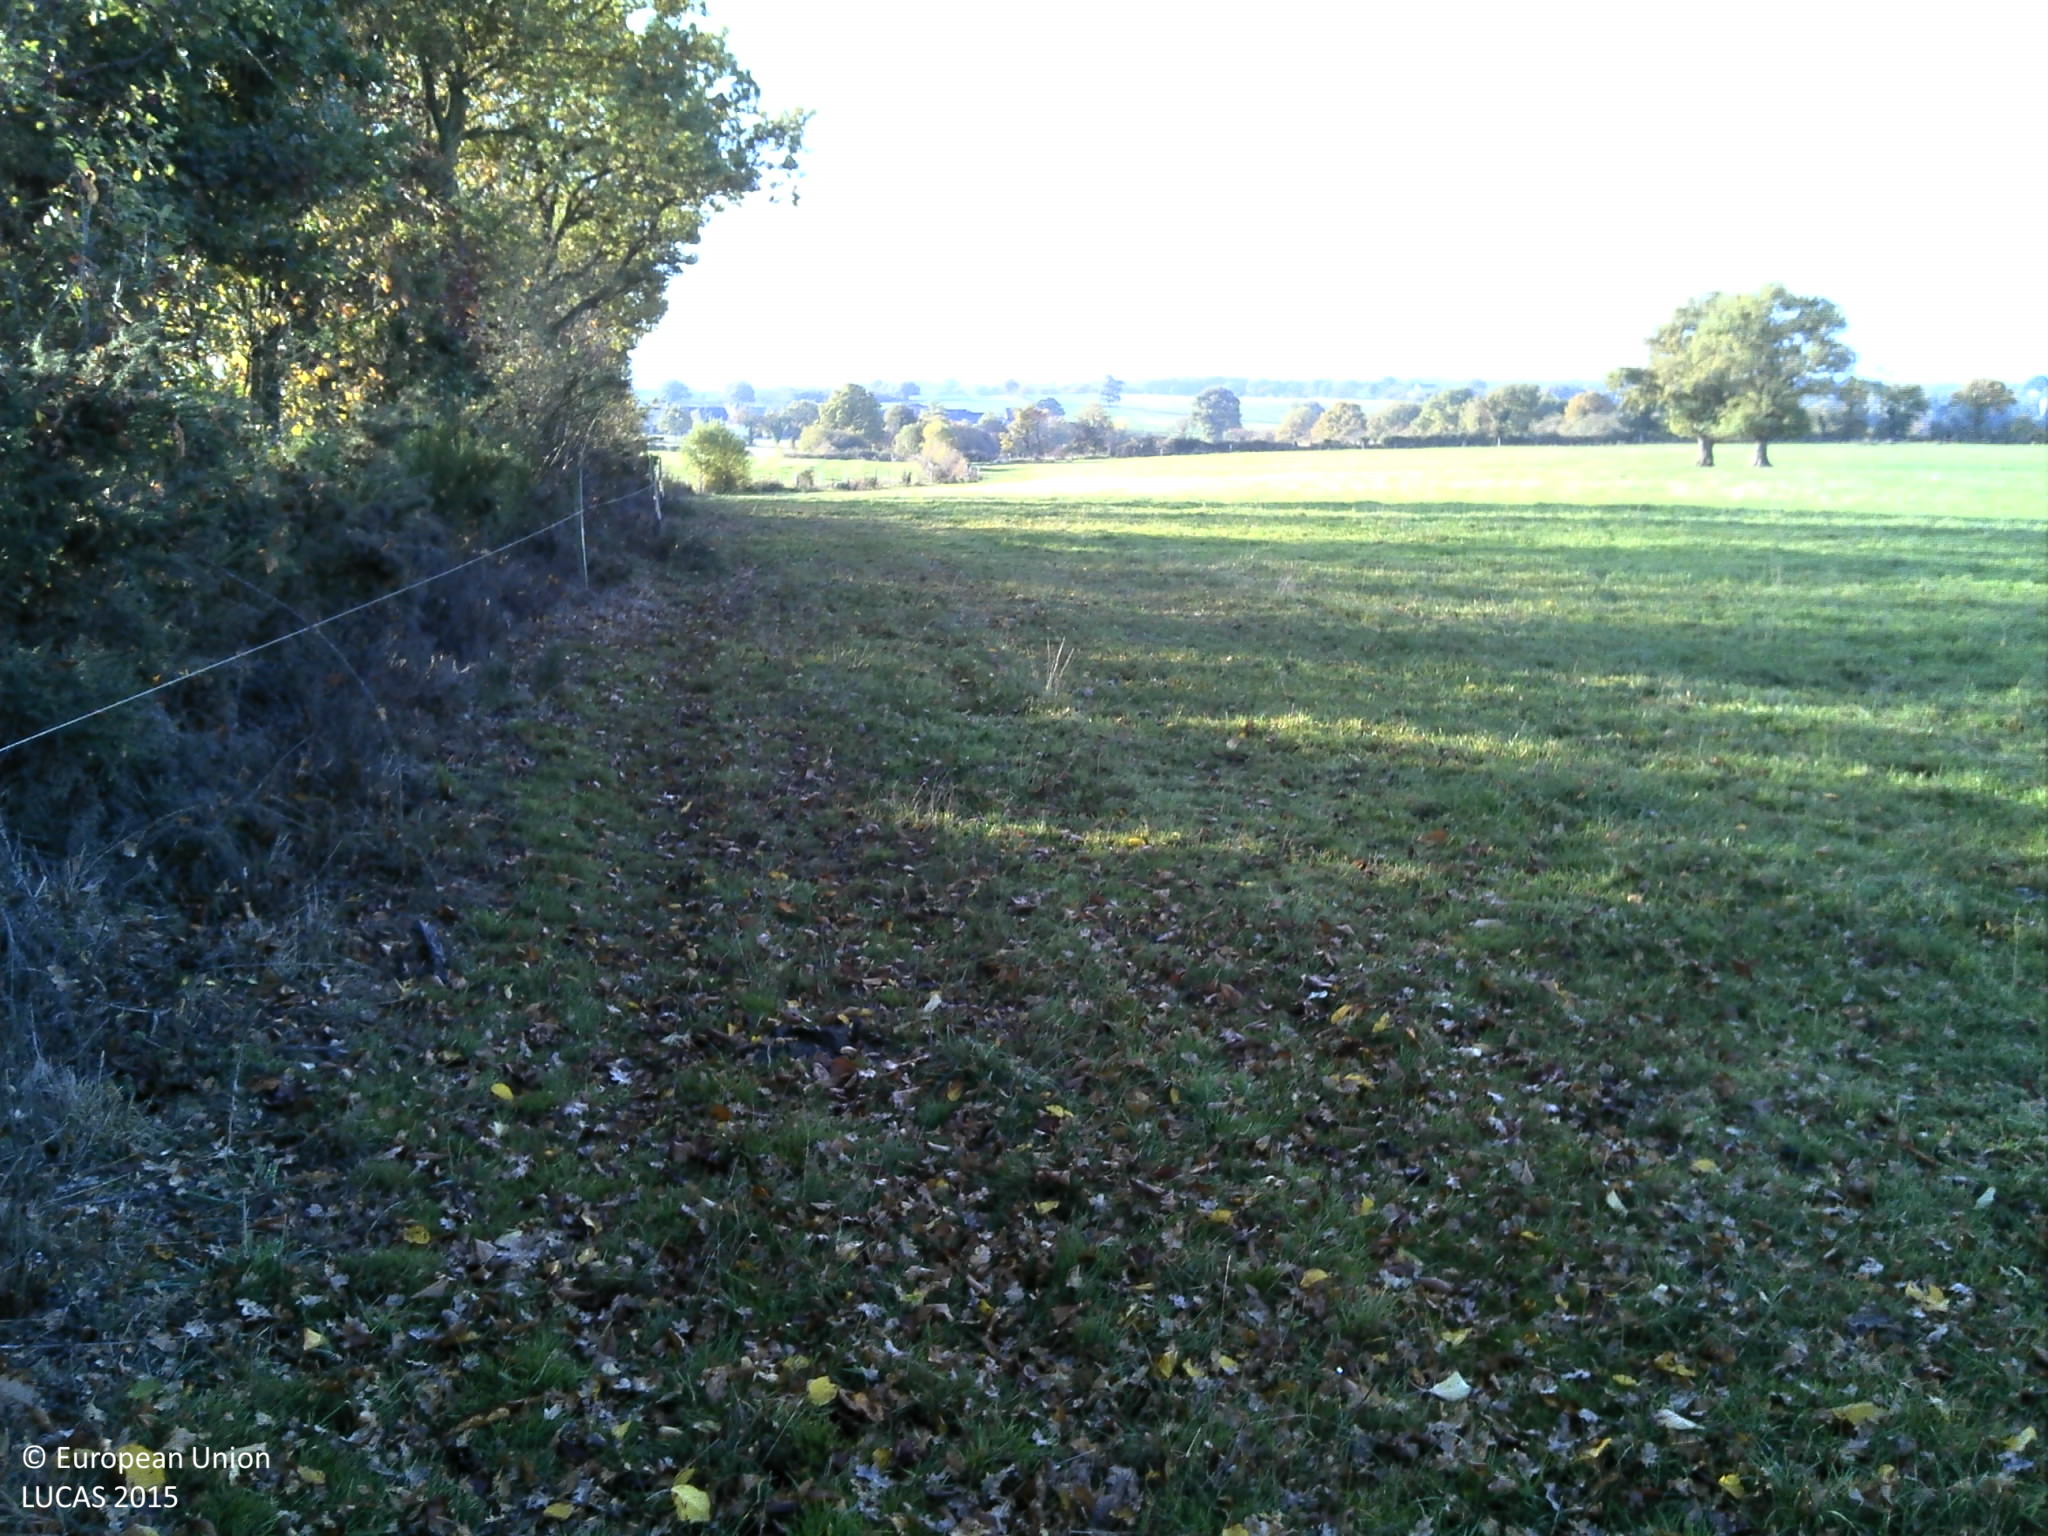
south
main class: Grassland
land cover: Grassland with sparse tree/shrub cover
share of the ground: > 75 %
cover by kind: herbaceous plants 95 %, broadleaved forest trees 5 %
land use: Agriculture (excluding fallow land and kitchen gardens)
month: November
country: FR
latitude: 47.5923
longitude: -1.0622
